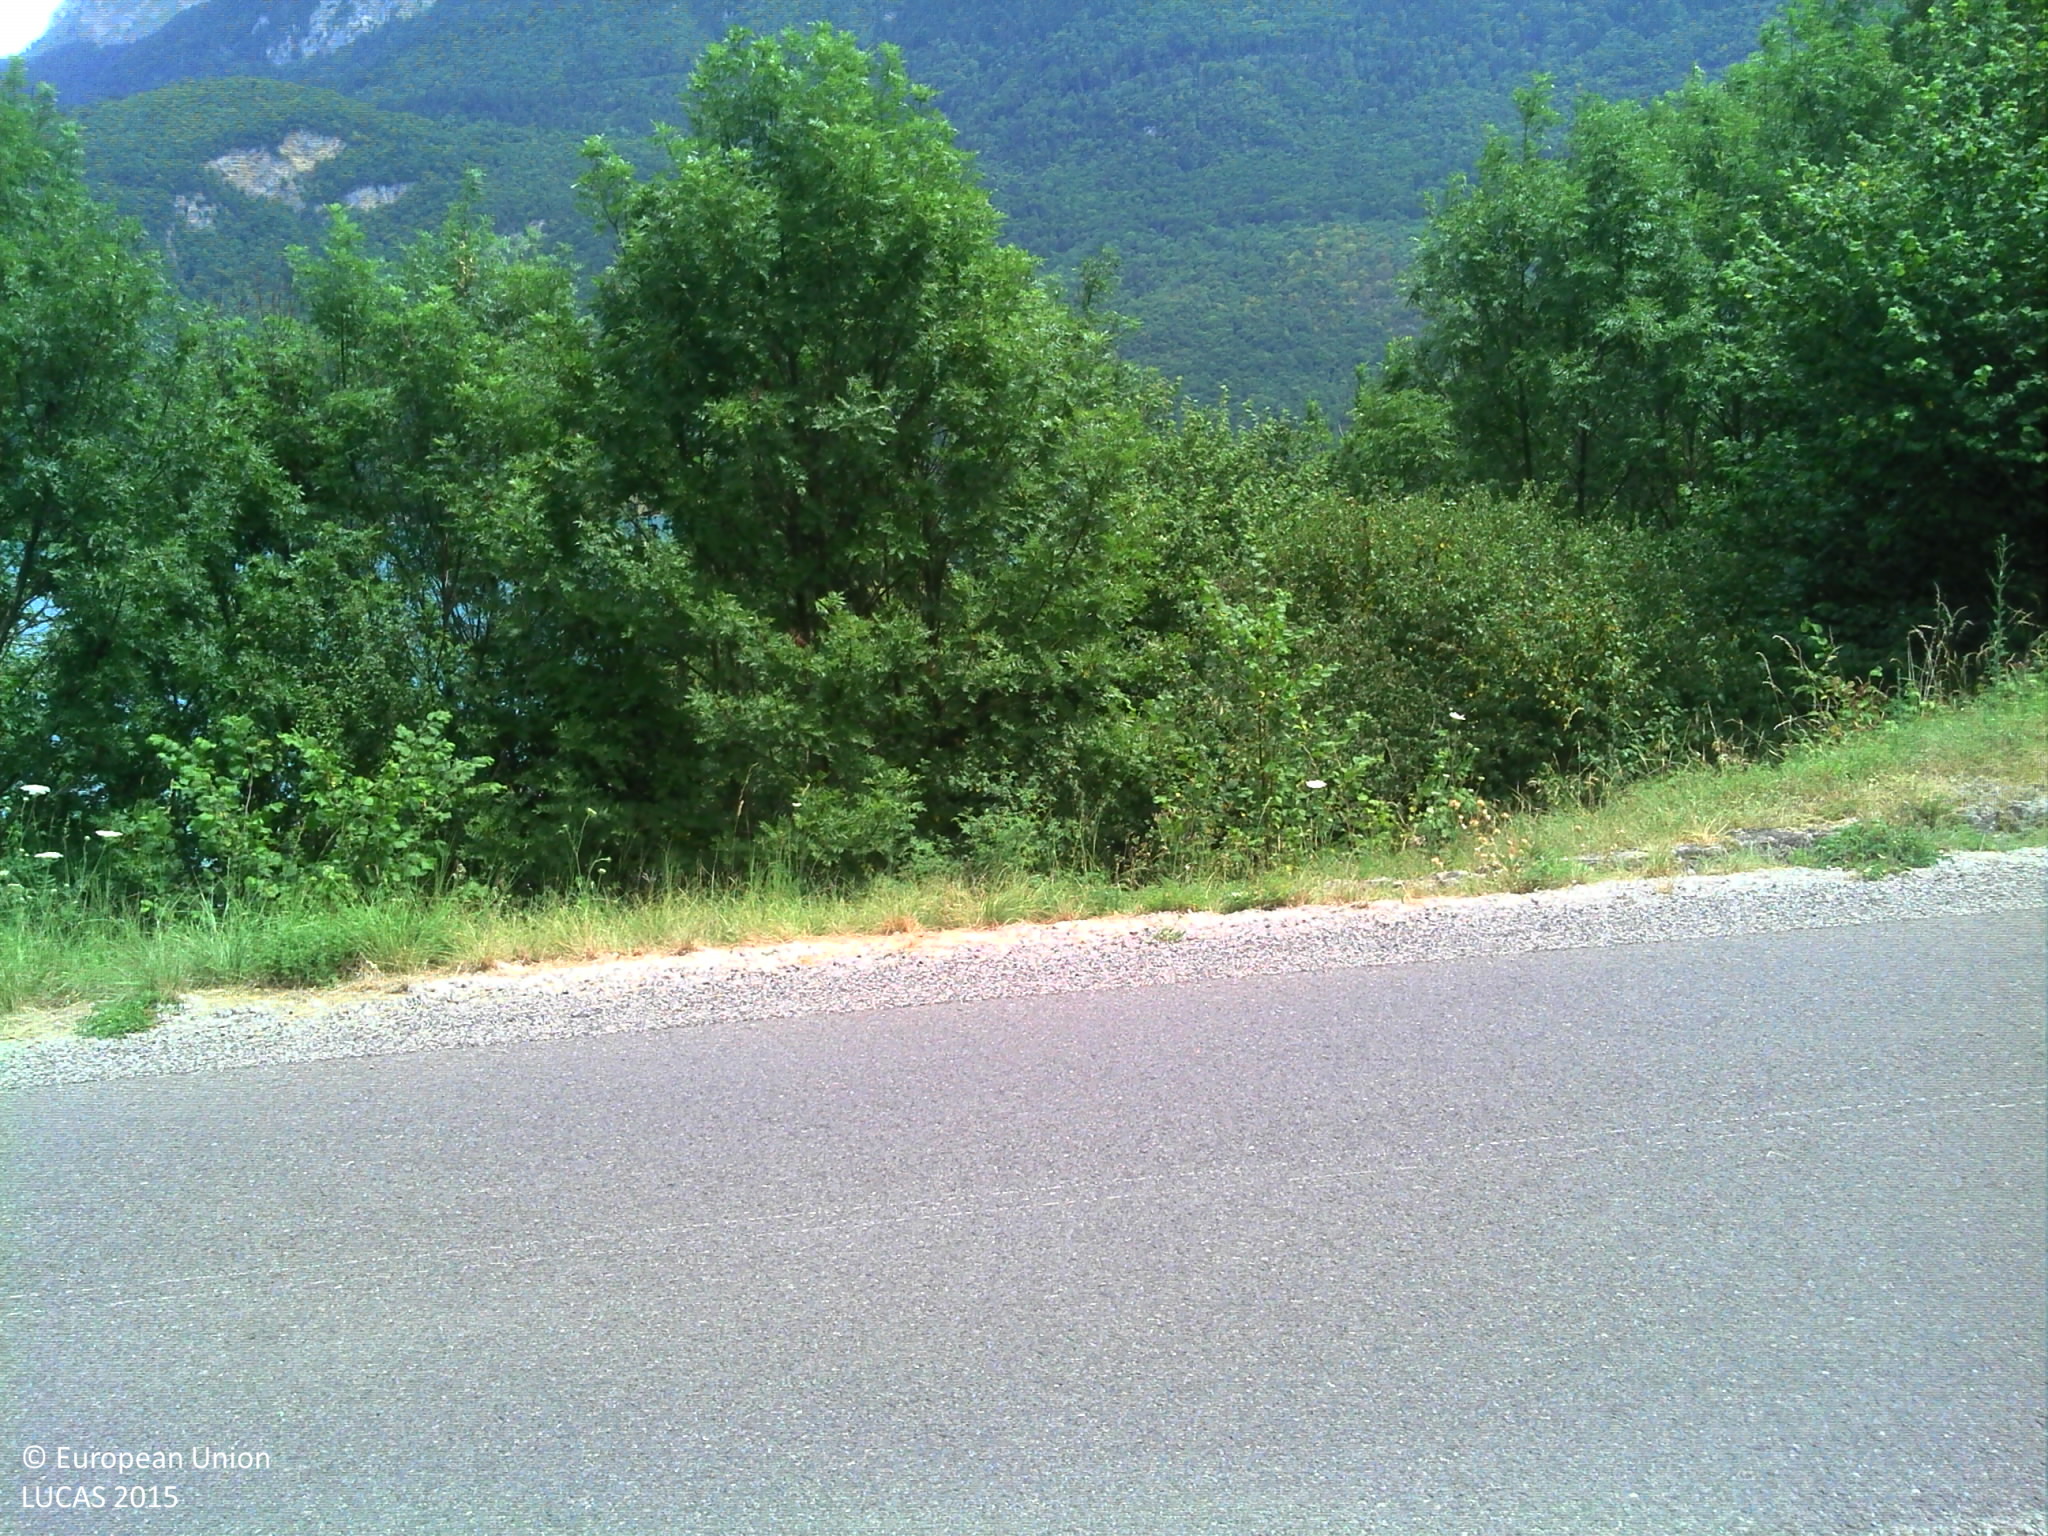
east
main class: Grassland
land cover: Grassland with sparse tree/shrub cover
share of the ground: > 75 %
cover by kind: herbaceous plants 90 %, broadleaved forest trees 5 %, shrubs 5 %
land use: Semi-natural and natural areas not in use
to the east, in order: Grassland with sparse tree/shrub cover; Ditches and canals; Paved roads, cycling and walking lanes; Grassland with sparse tree/shrub cover; Broadleaved woodland; Artificial constructions in urban areas; Inland fresh water bodies
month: July
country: FR
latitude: 45.8151
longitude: 6.2076
